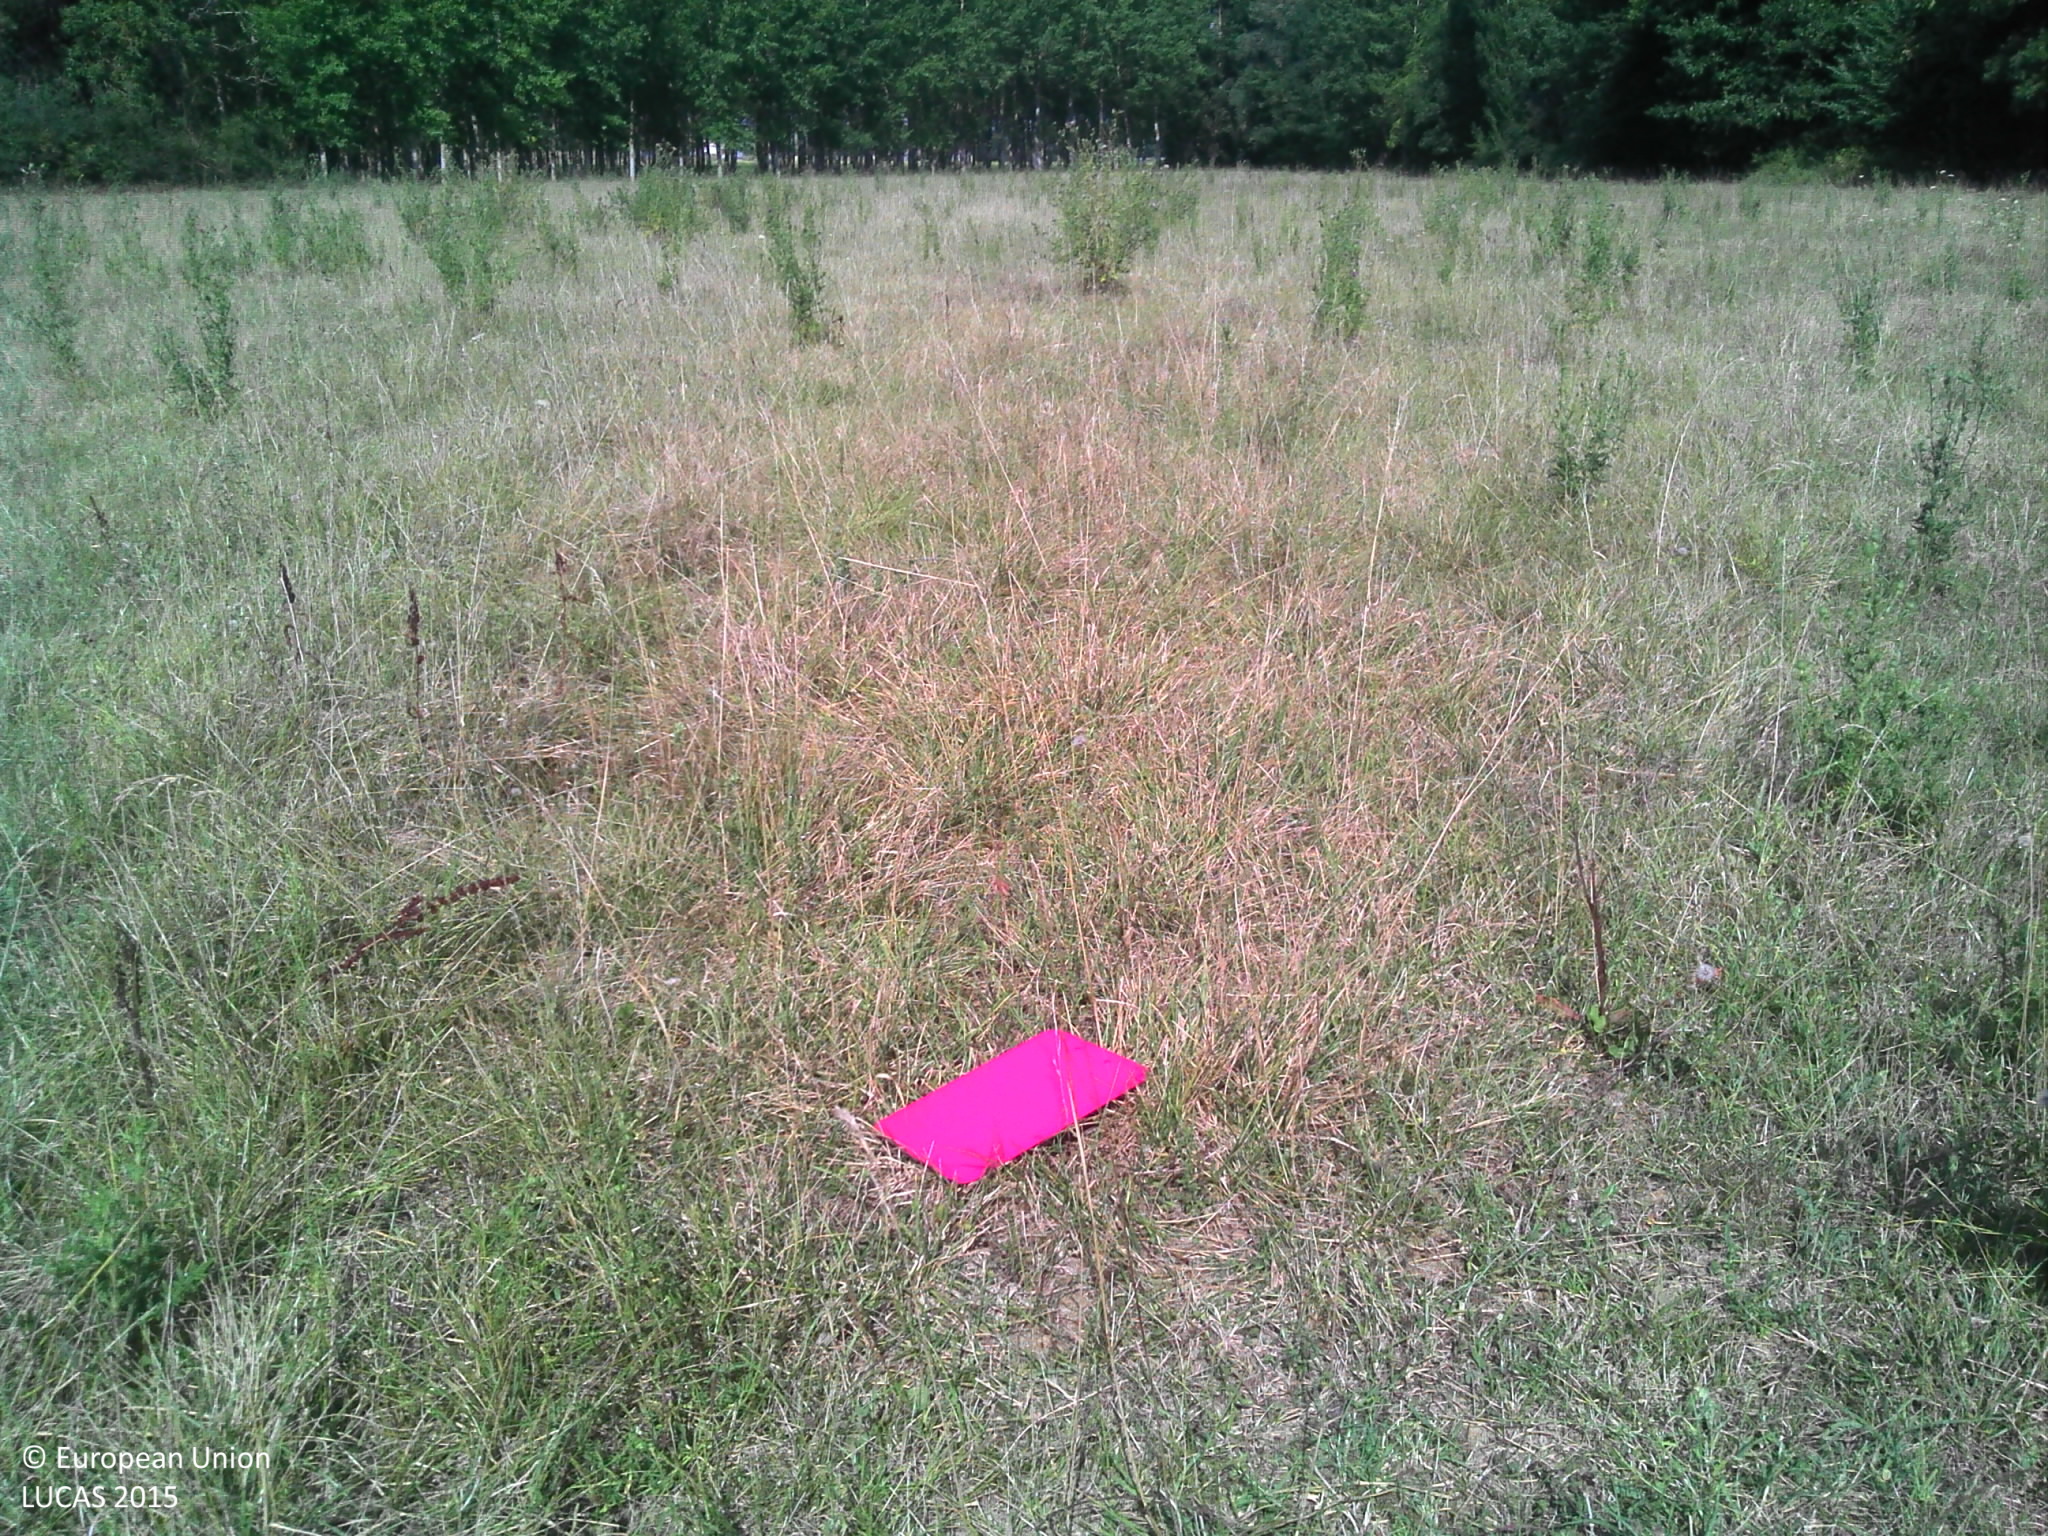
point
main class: Grassland
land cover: Grassland without tree/shrub cover
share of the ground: > 75 %
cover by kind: herbaceous plants 100 %
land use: Agriculture (excluding fallow land and kitchen gardens)
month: August
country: FR
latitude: 44.1666
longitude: 1.3073
